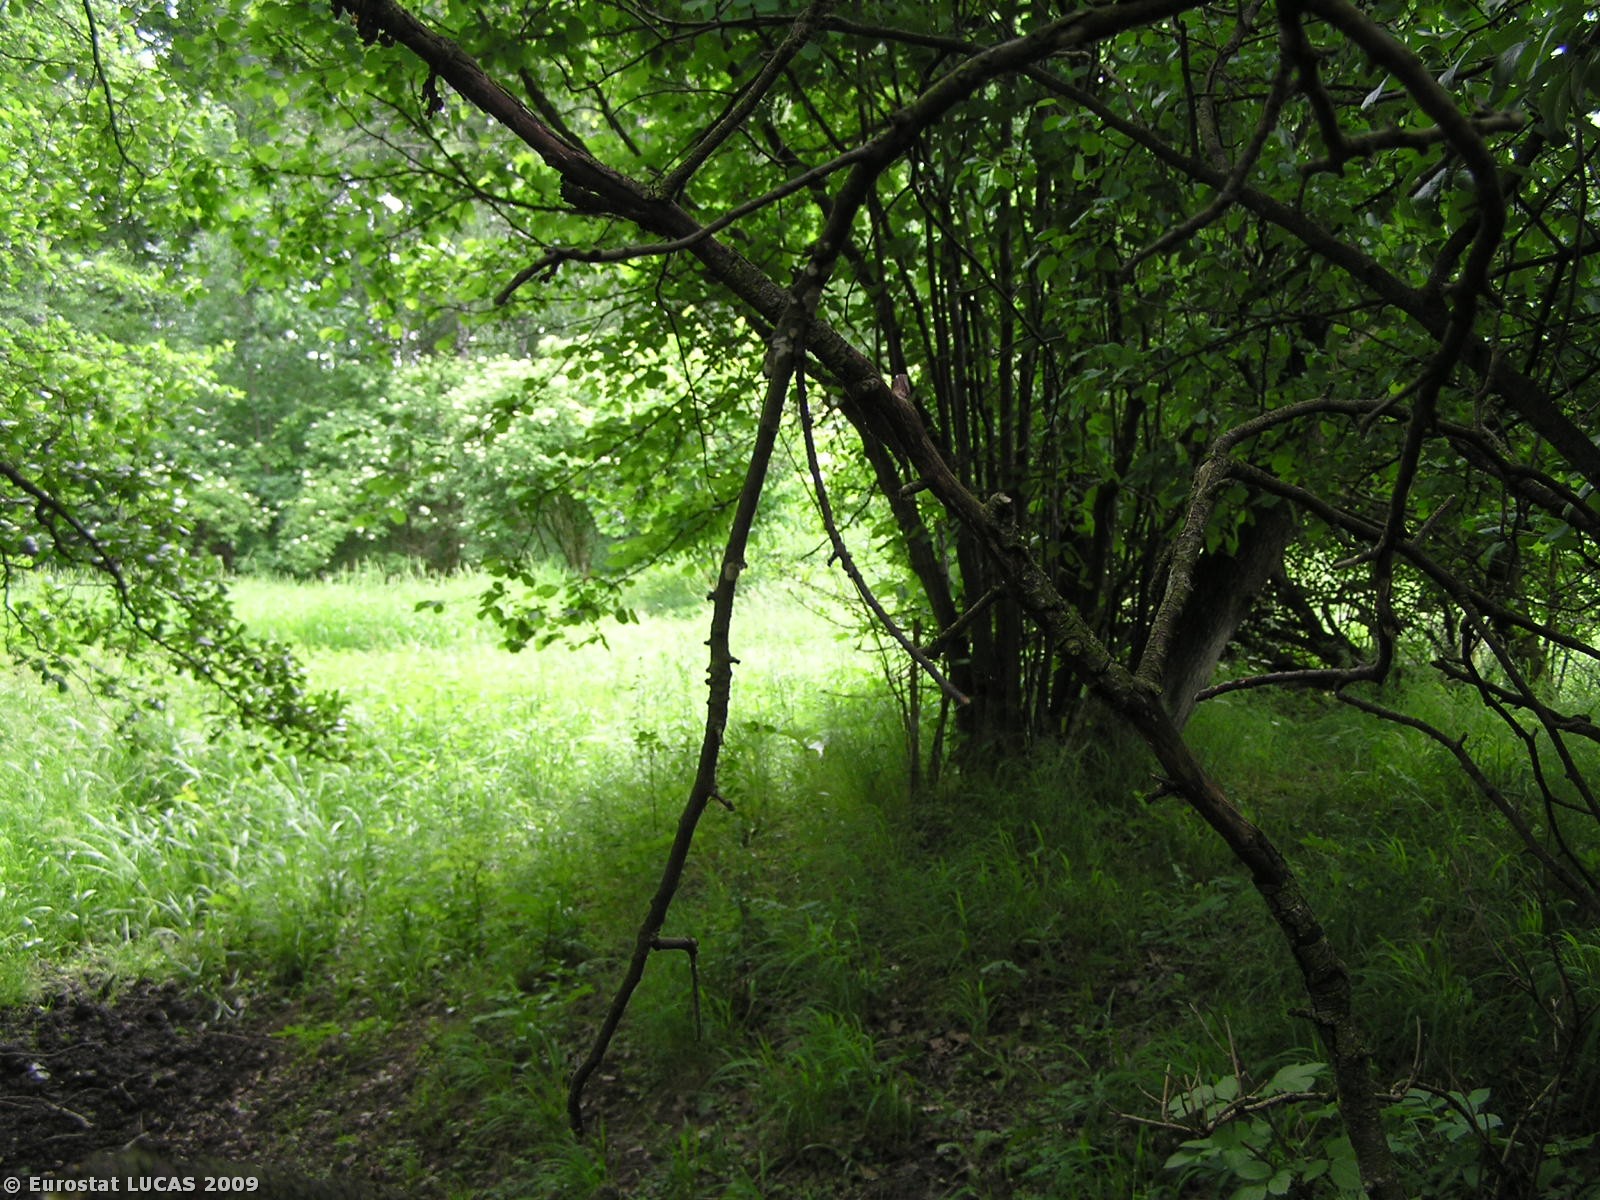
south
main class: Woodland
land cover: Broadleaved woodland
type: non-riverine alder, birch or aspen forest
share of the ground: > 75 %
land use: Unused
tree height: > 5 m
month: June
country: CZ
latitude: 50.1802
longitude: 17.6454
